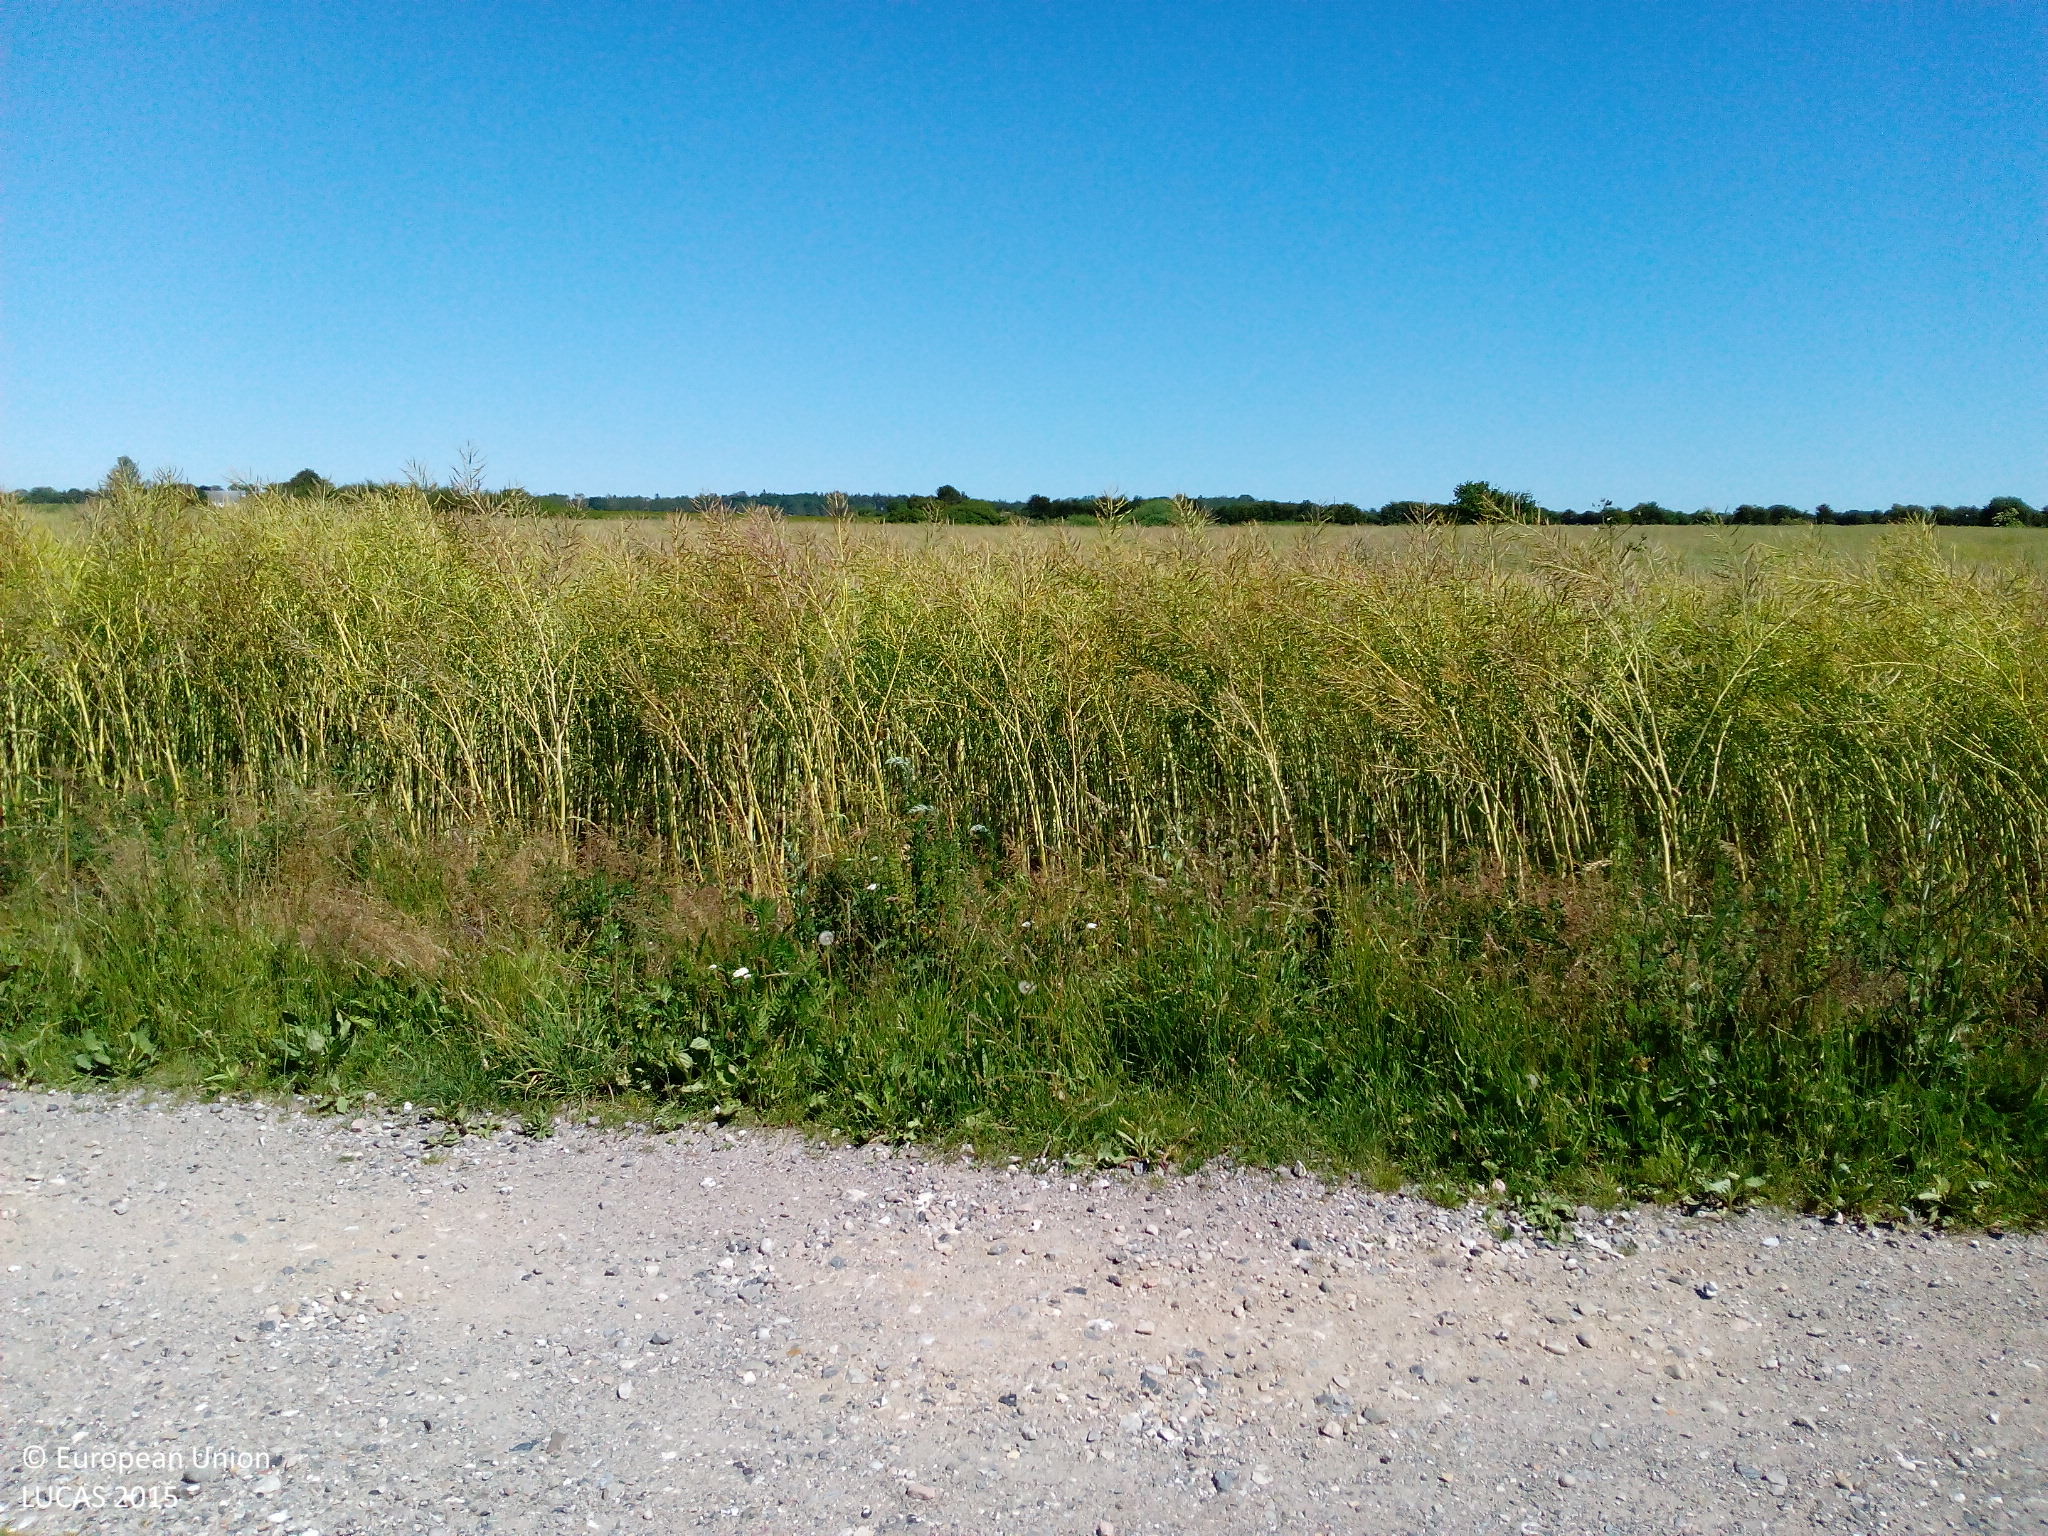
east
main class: Cropland
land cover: Rape and turnip rape
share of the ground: > 75 %
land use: Agriculture (excluding fallow land and kitchen gardens)
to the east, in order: Shruby margins; Tracks; Shruby margins; Rape and turnip rape; Broadleaved woodland; Ditches and canals; Broadleaved woodland; Maize
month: July
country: DK
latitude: 55.1148
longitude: 11.7703
